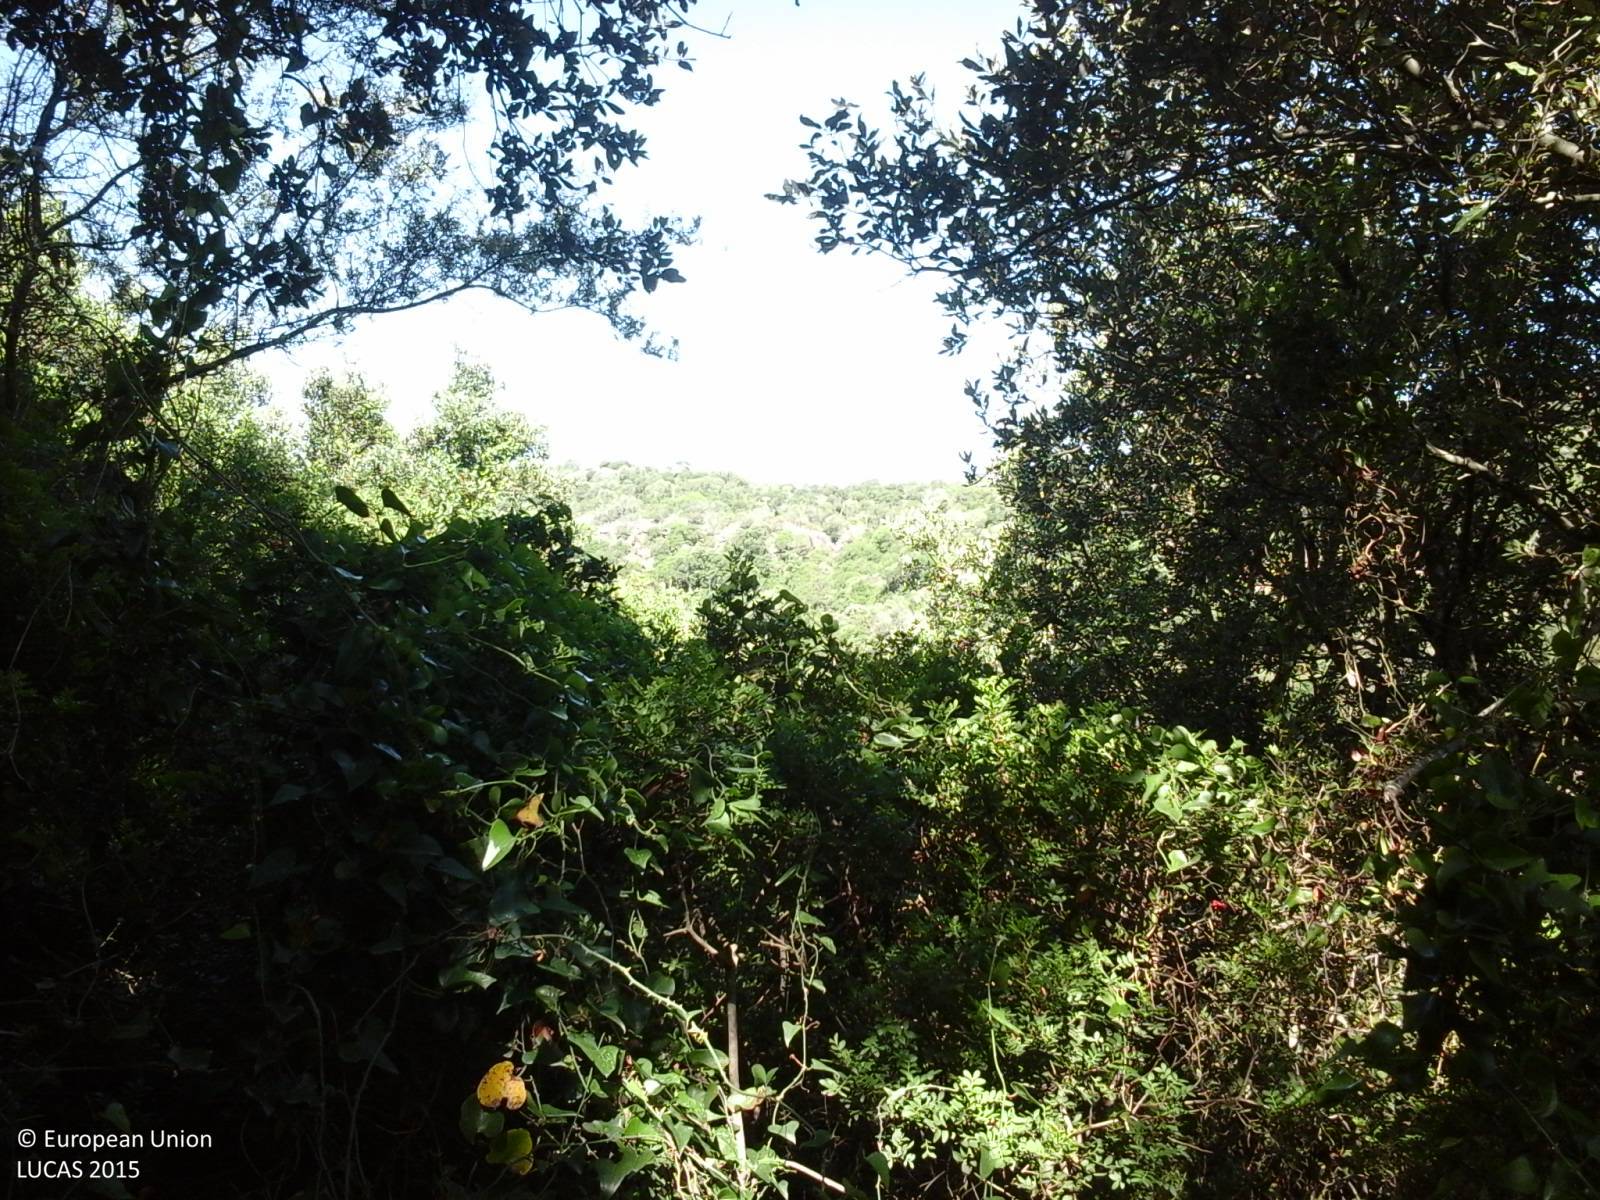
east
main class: Woodland
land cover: Broadleaved woodland
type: broadleaved evergreen forest
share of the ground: > 75 %
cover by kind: broadleaved forest trees 95 %, shrubs 5 %
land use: Semi-natural and natural areas not in use
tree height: > 5 m
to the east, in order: Broadleaved woodland; Electric lines; Broadleaved woodland
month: June
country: IT
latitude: 40.3569
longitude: 9.5666
